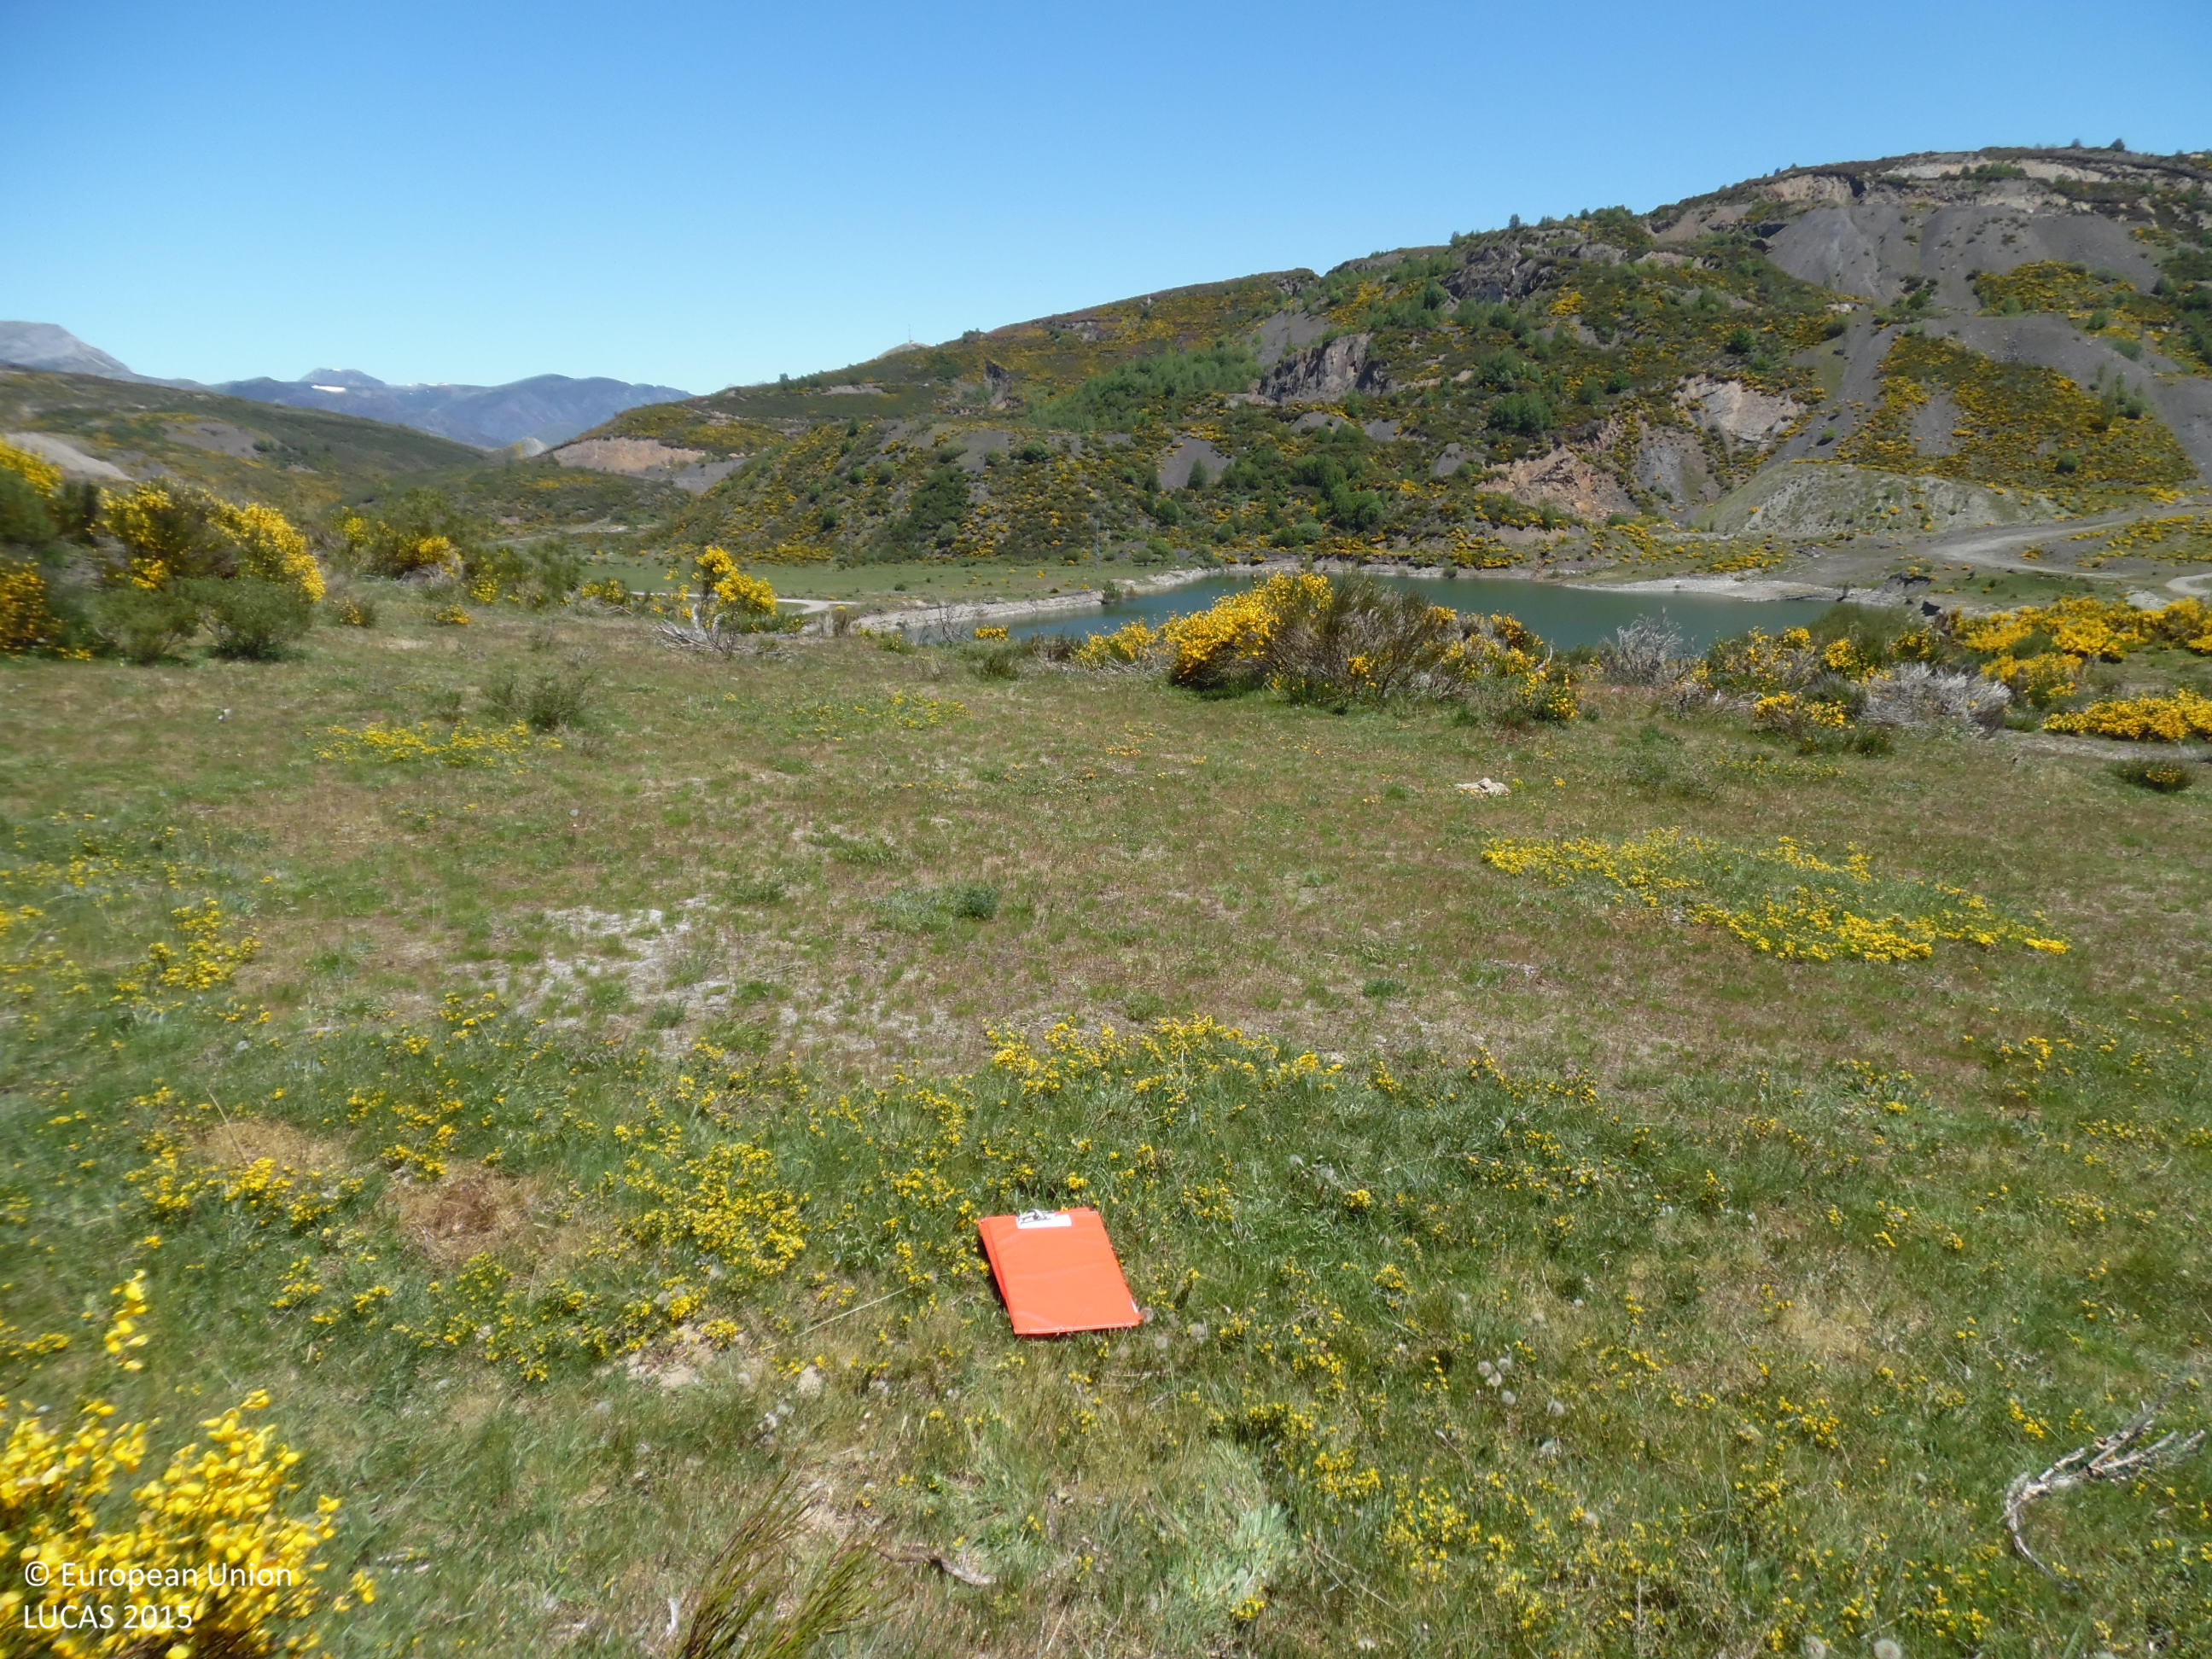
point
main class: Shrubland
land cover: Shrubland with sparse tree cover
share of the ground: 50 - 75 %
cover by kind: shrubs 95 %, broadleaved forest trees 5 %
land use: Other primary production
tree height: < 5 m
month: May
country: ES
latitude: 42.9203
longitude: -6.2005
